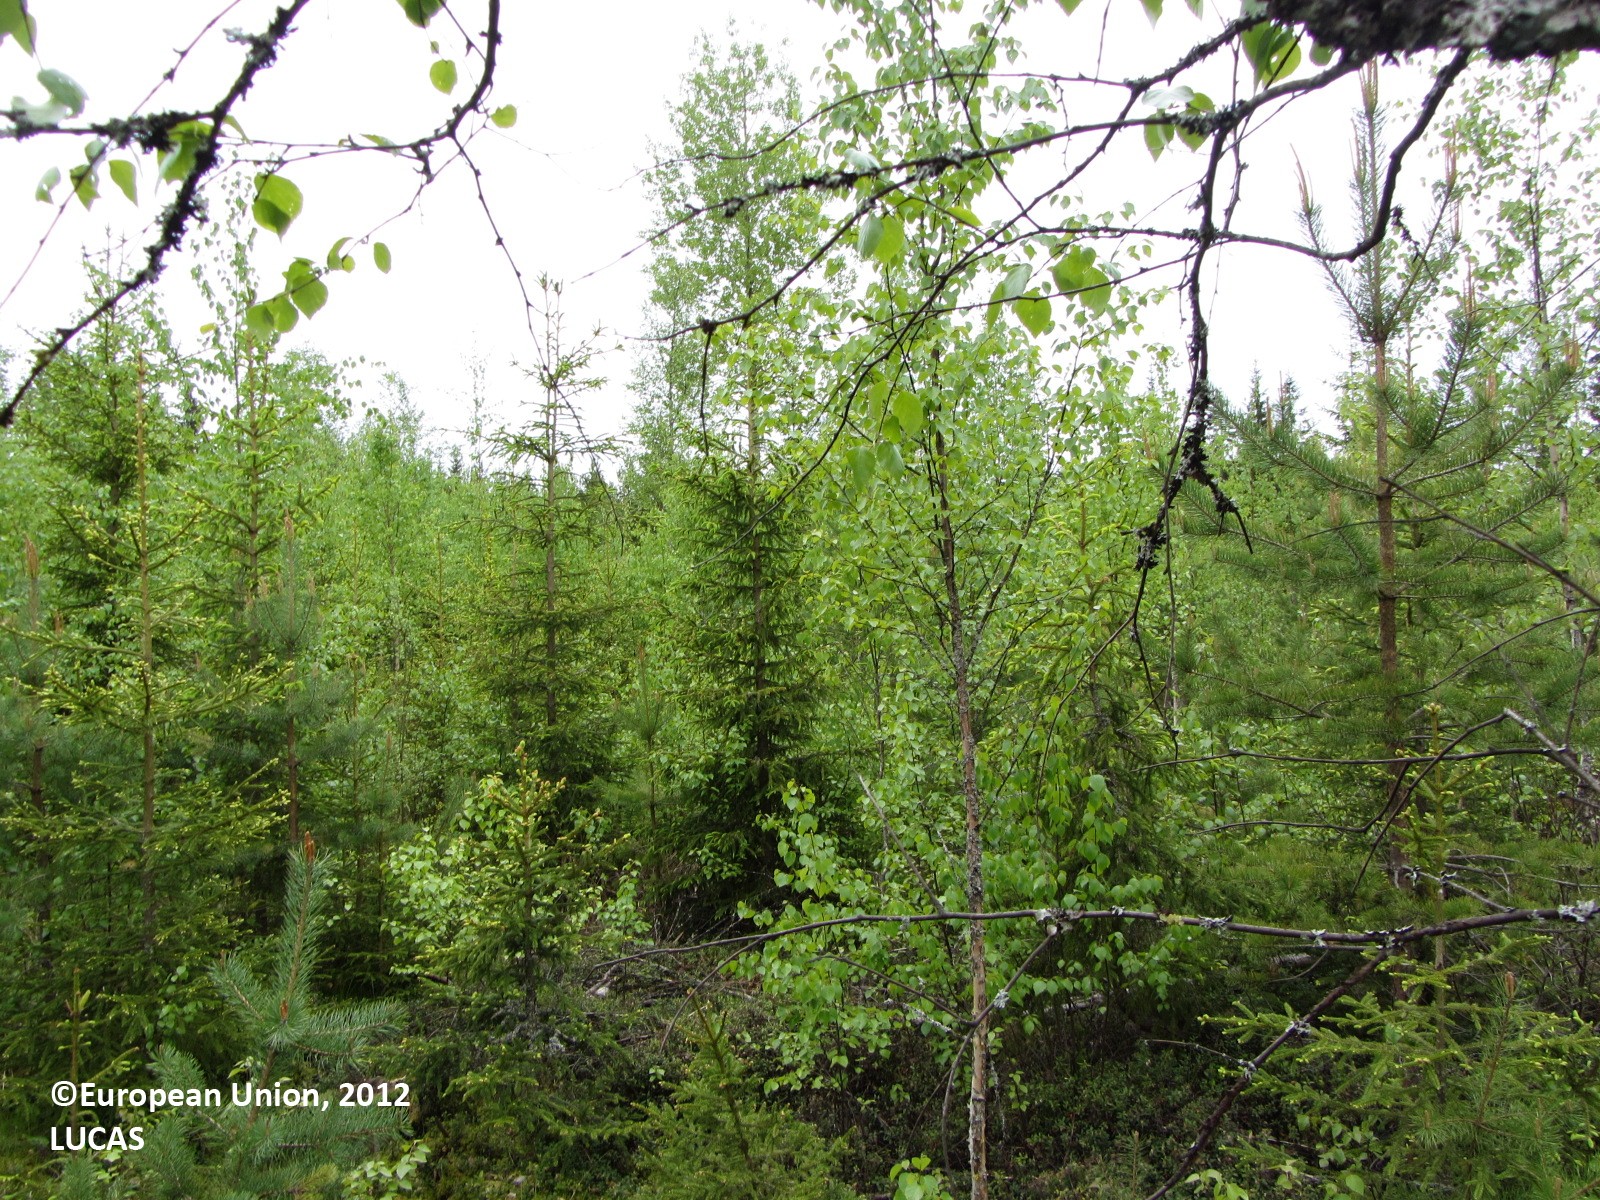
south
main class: Woodland
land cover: Other mixed woodland
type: hemiboreal forest and nemoral coniferous forest and mixed broadleaved-coniferous forest
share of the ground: > 75 %
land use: Forestry
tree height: < 5 m
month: June
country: FI
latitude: 61.7371
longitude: 24.8899
